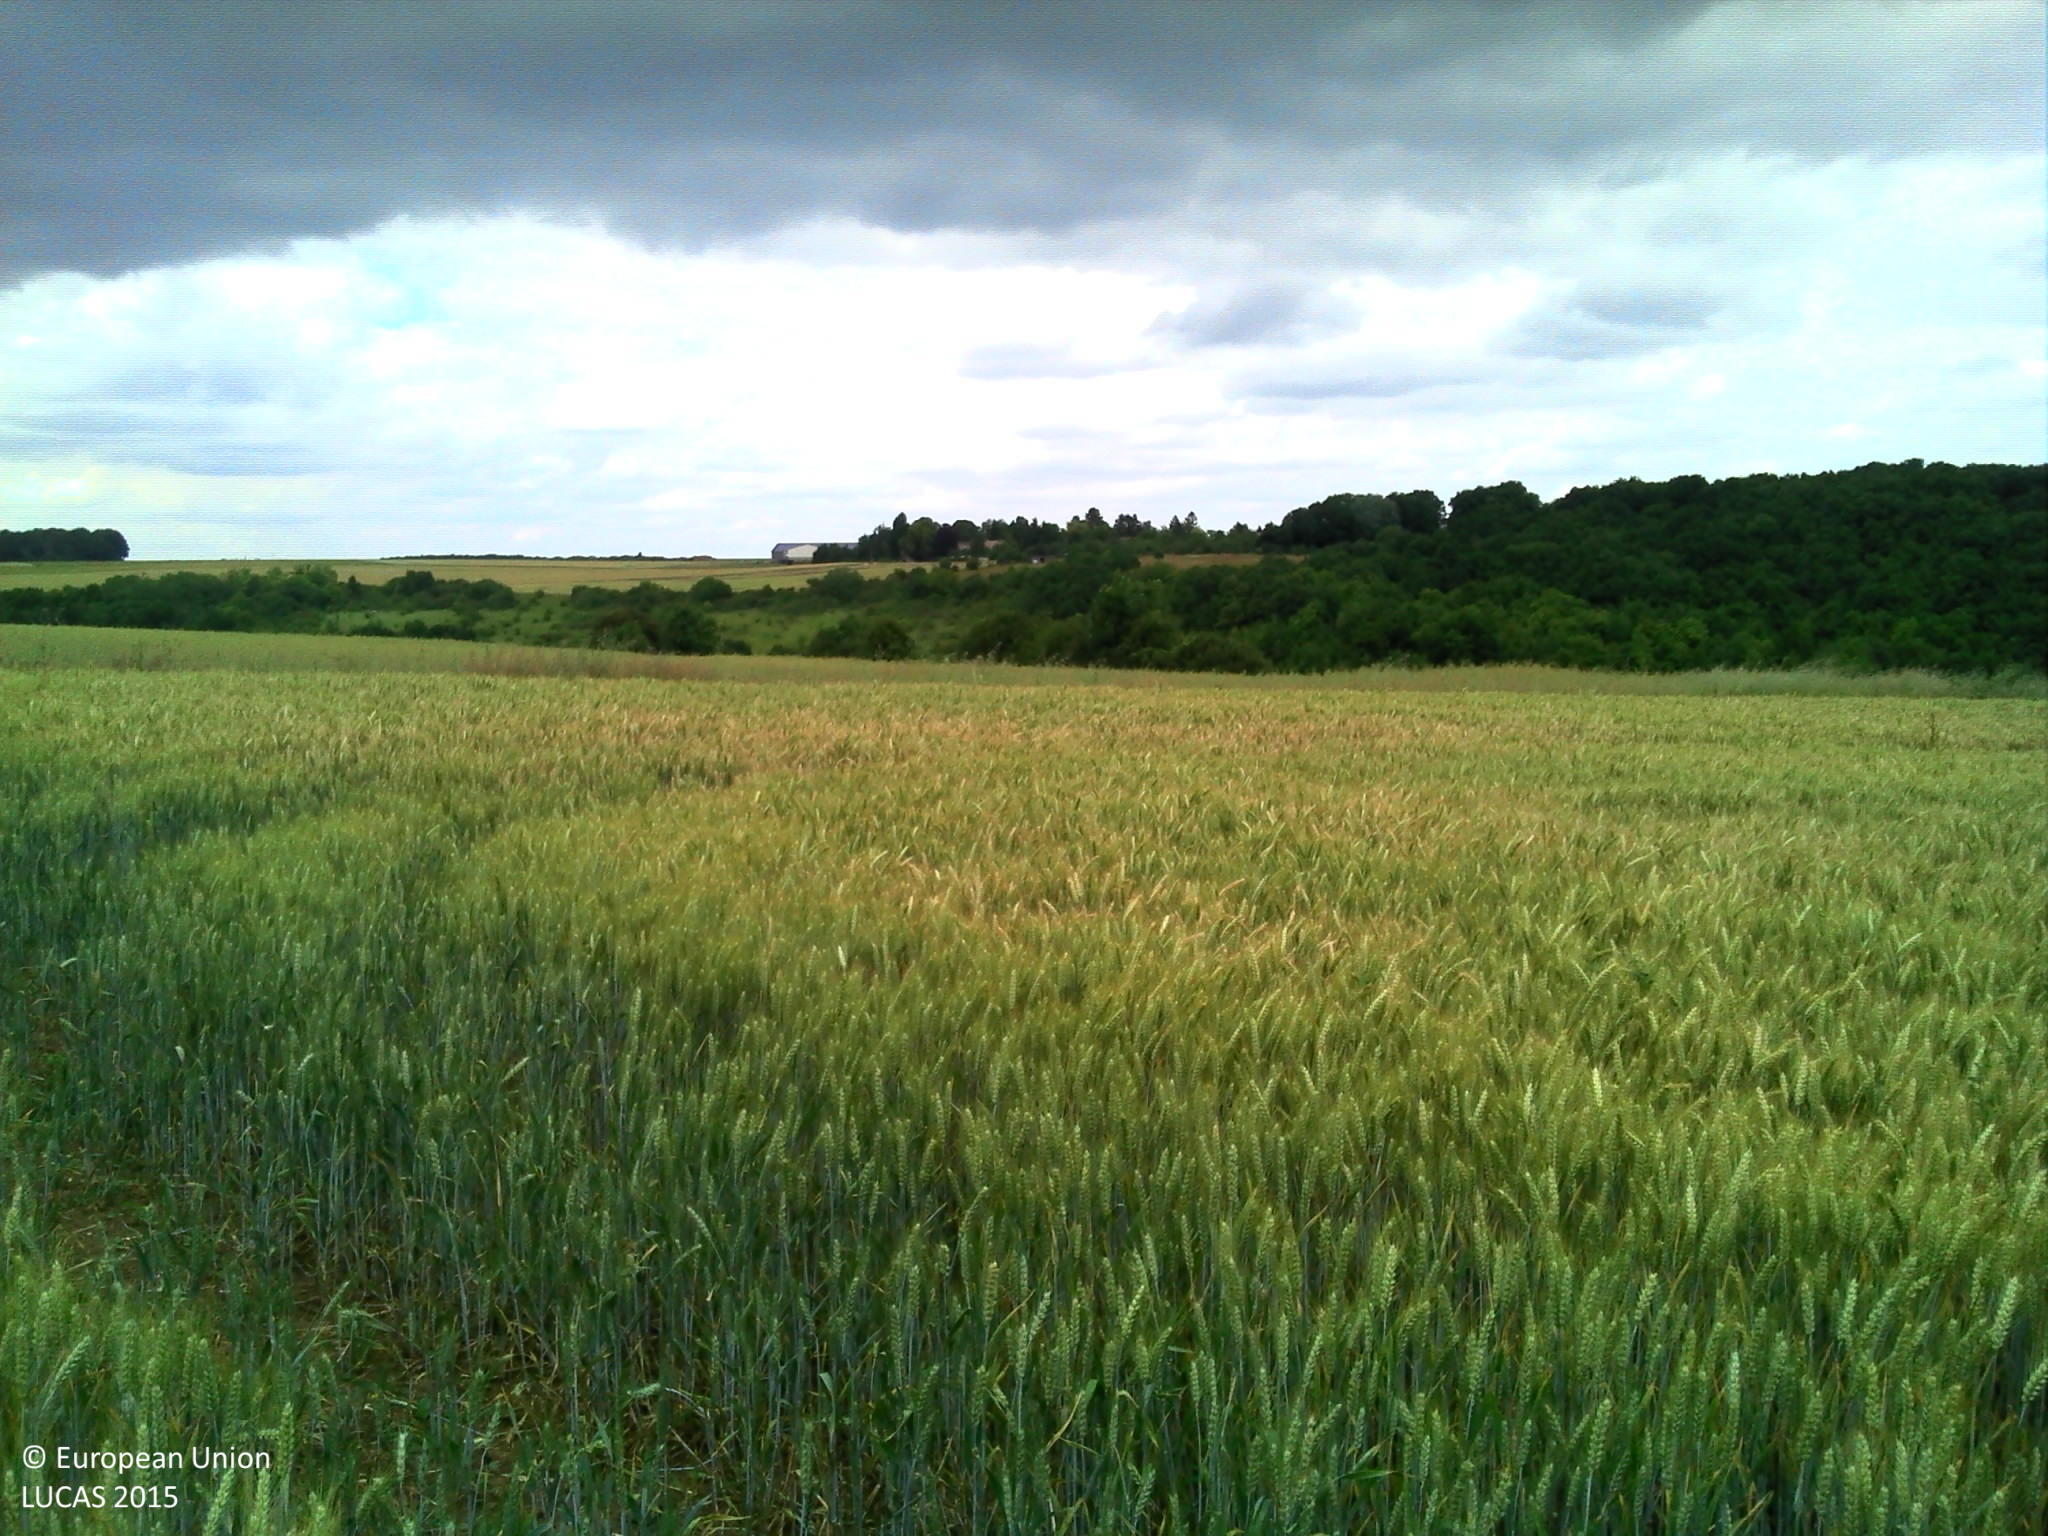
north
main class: Cropland
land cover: Common wheat
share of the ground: > 75 %
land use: Agriculture (excluding fallow land and kitchen gardens)
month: June
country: FR
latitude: 49.0524
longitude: 1.2642
